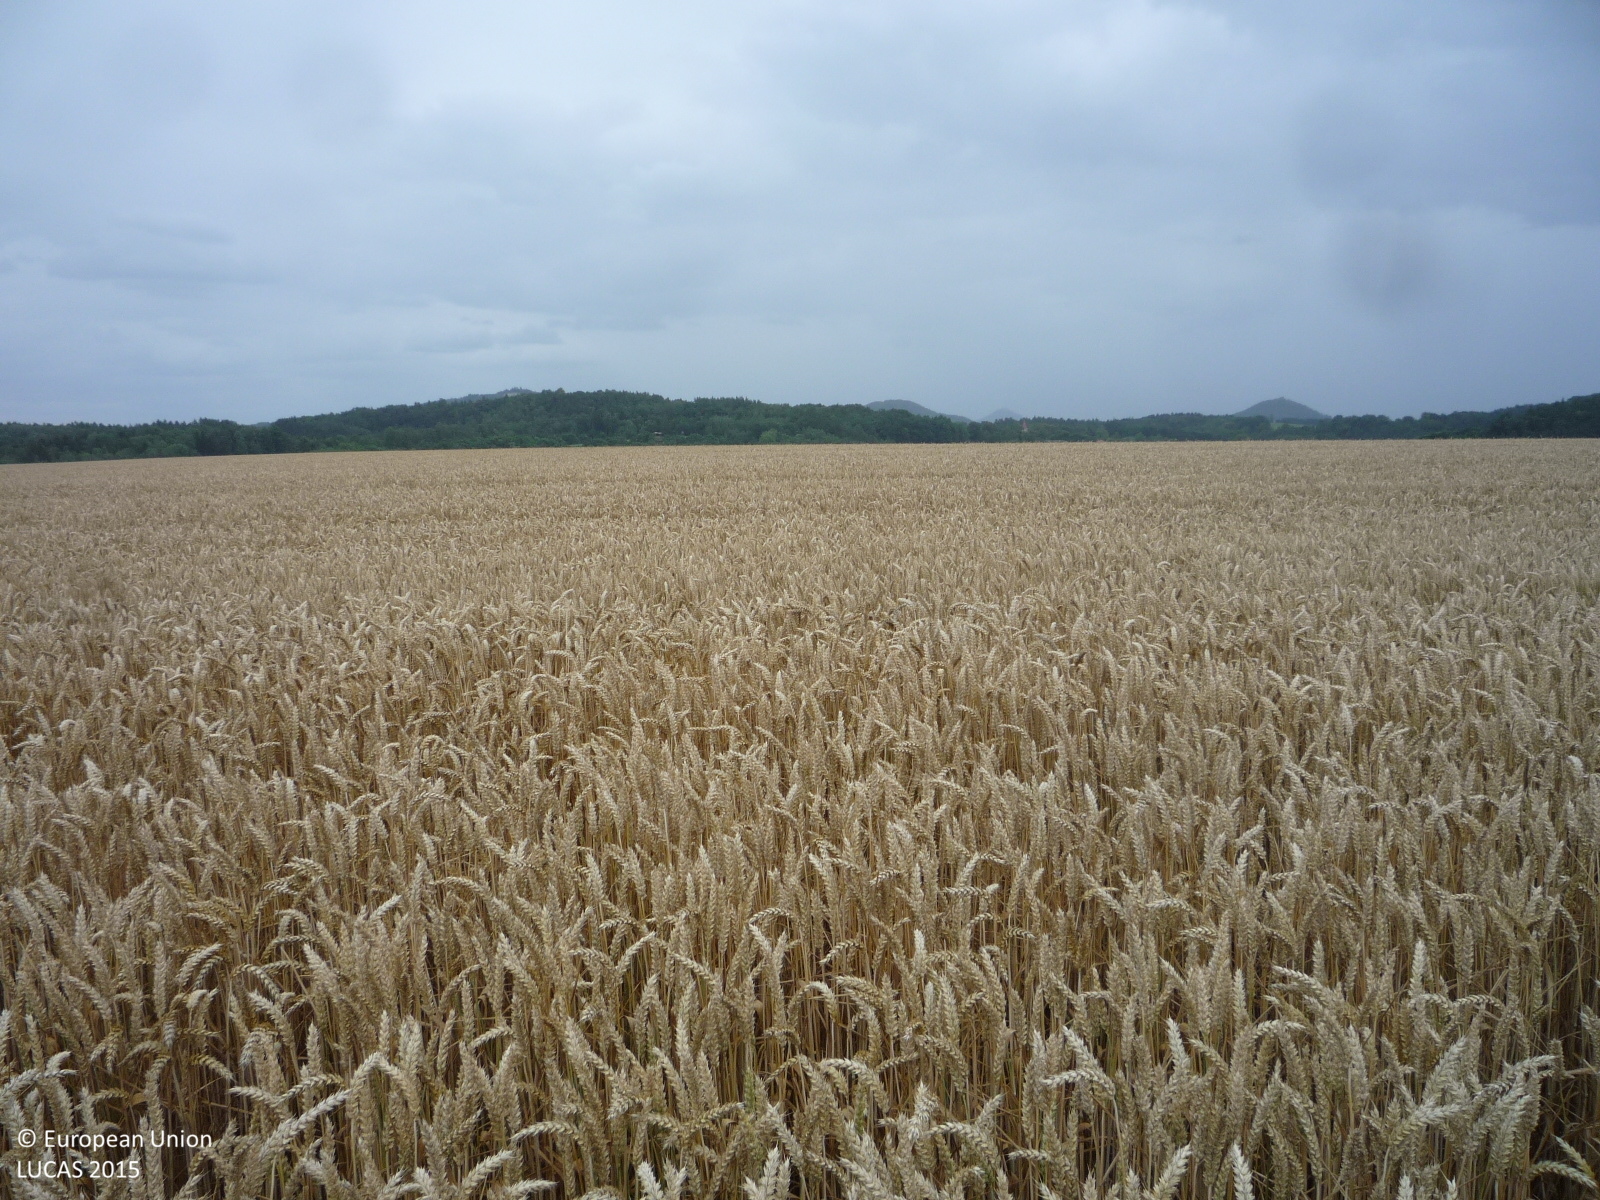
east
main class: Cropland
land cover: Common wheat
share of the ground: > 75 %
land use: Agriculture (excluding fallow land and kitchen gardens)
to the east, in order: Common wheat
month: July
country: CZ
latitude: 50.5814
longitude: 14.5070
